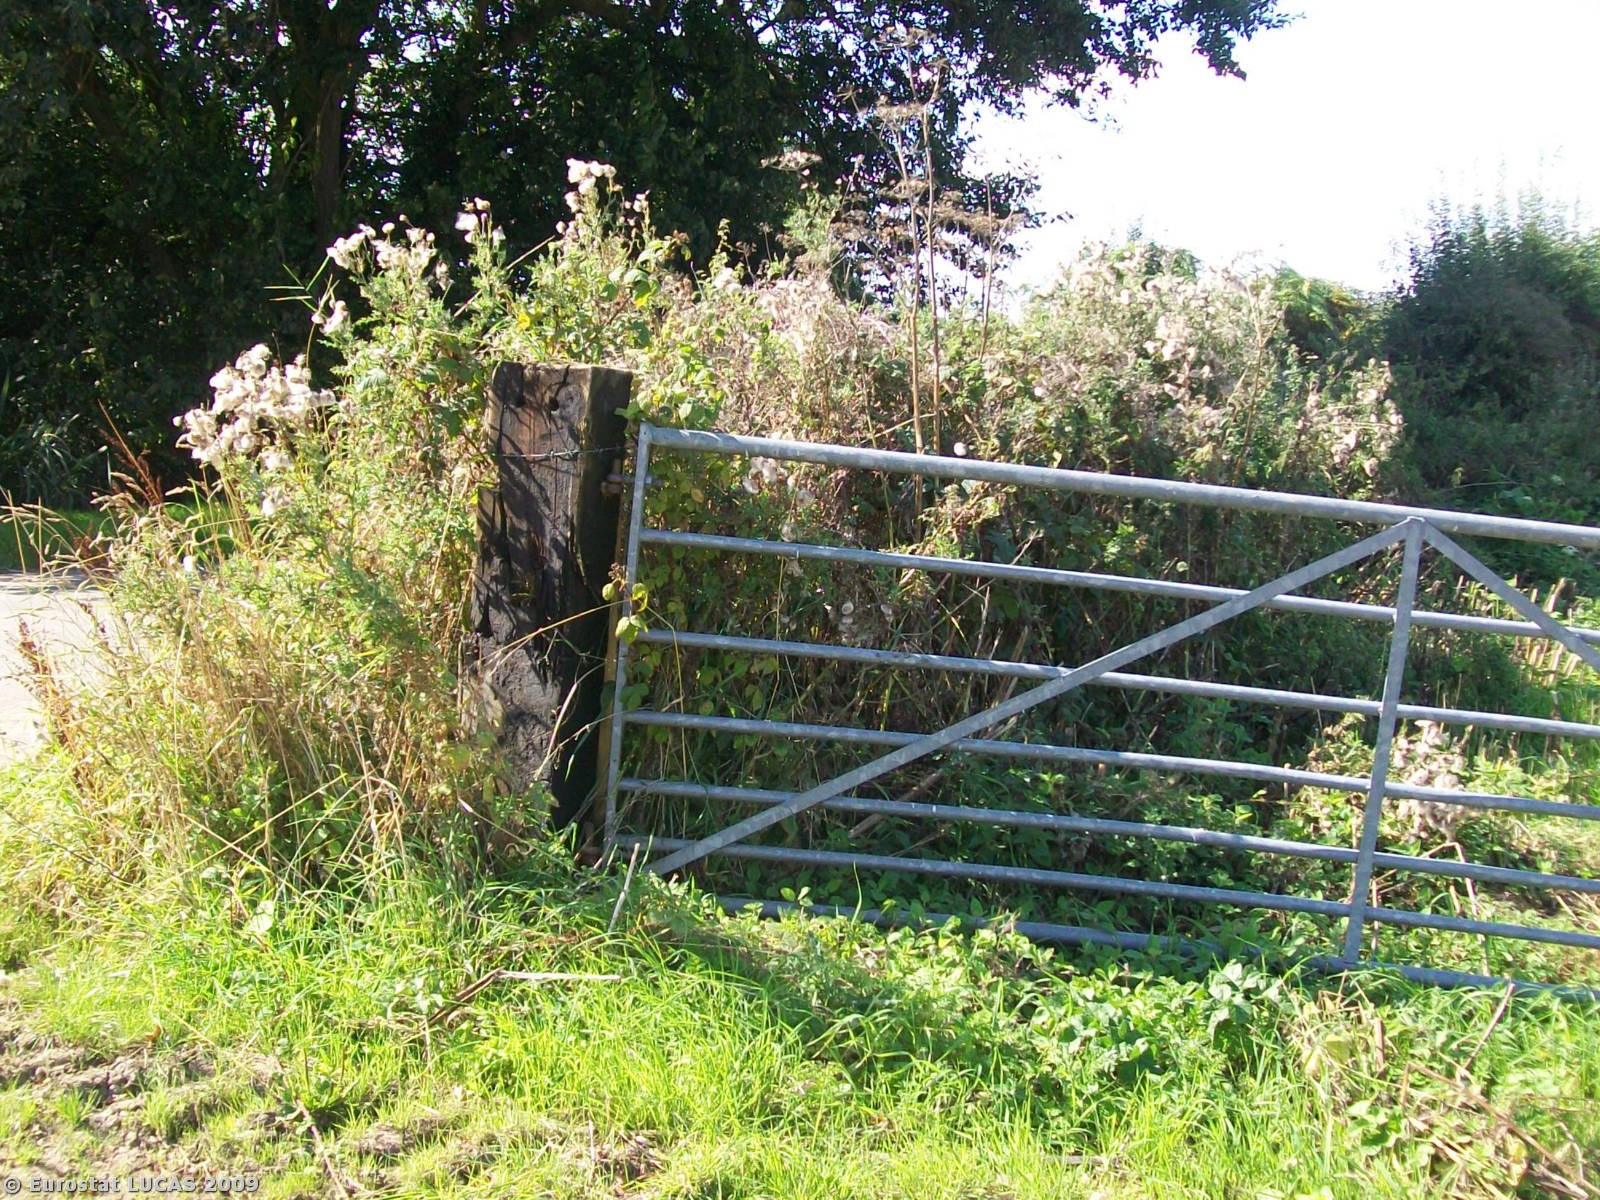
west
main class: Cropland
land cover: Rape and turnip rape
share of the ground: > 75 %
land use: Agriculture (excluding fallow land and kitchen gardens)
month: September
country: GB
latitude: 52.8274
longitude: -2.6391
